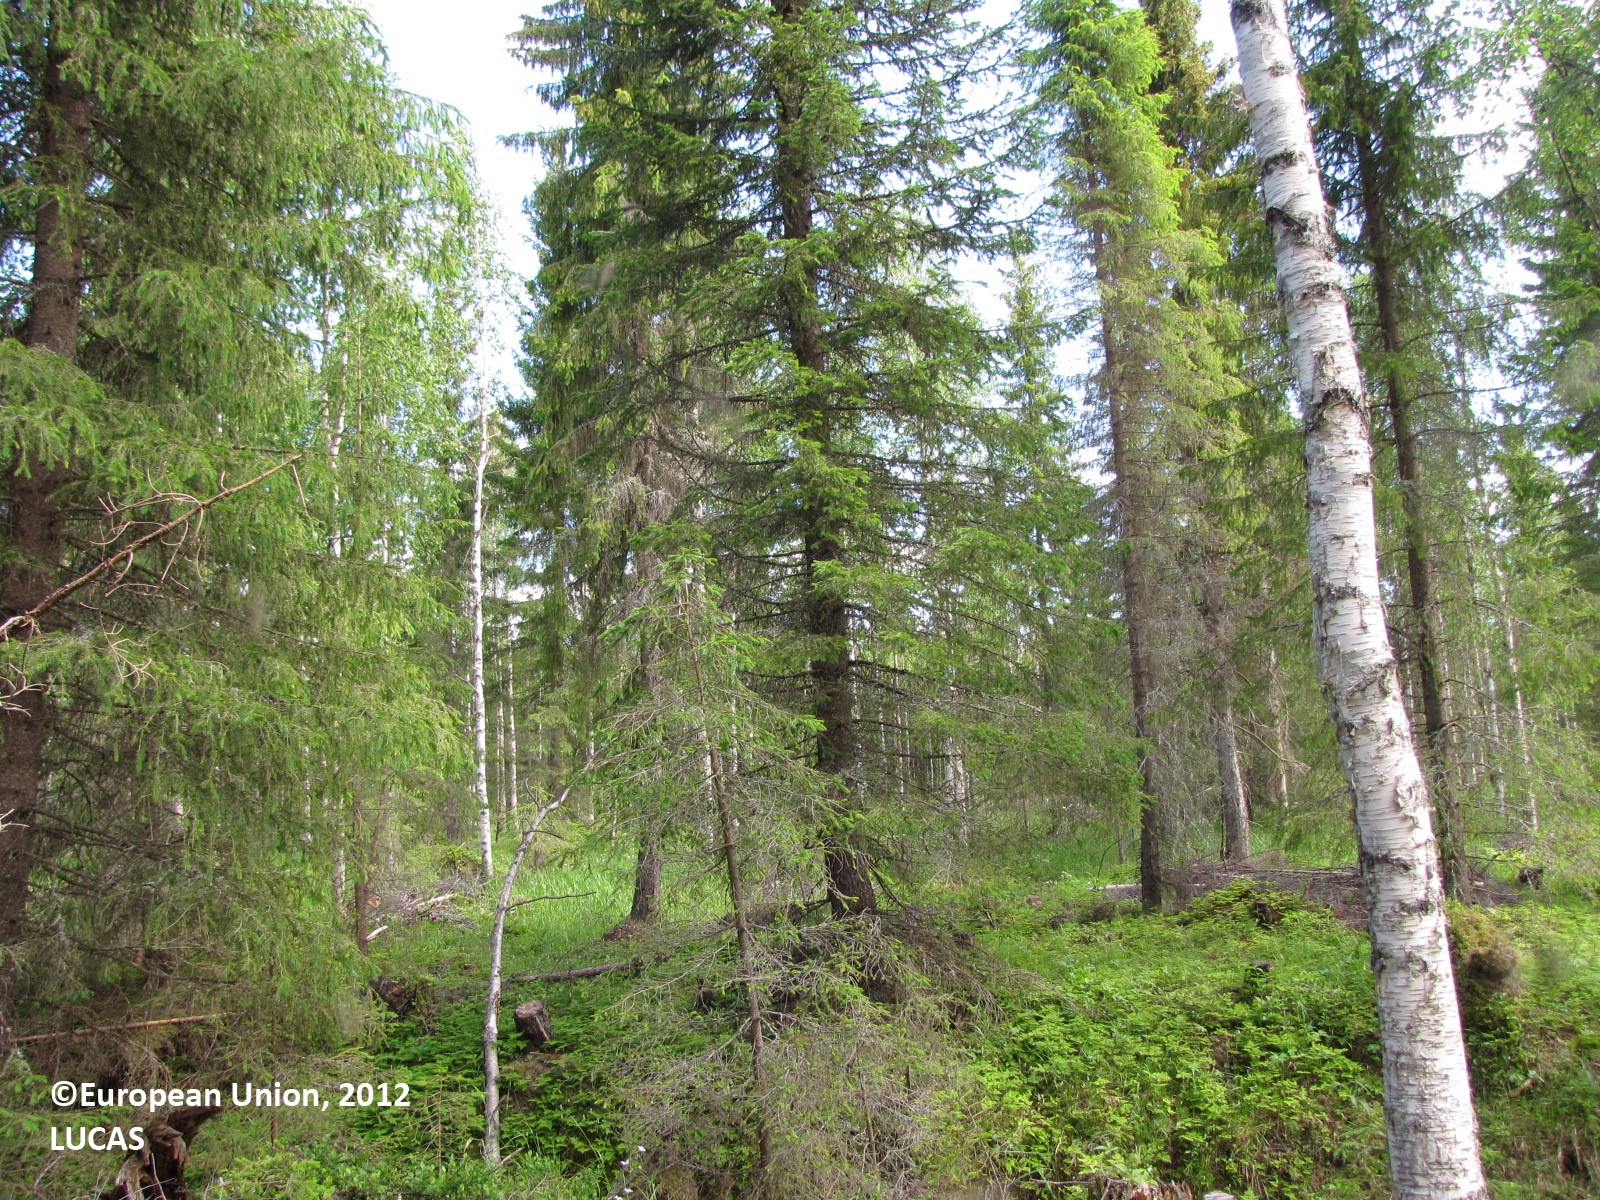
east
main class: Woodland
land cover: Spruce dominated coniferous woodland
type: boreal forest
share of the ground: 50 - 75 %
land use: Forestry
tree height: > 5 m
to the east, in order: Spruce dominated coniferous woodland; Ditches and canals; Spruce dominated mixed woodland; Ditches and canals; Other mixed woodland; Ditches and canals; Other mixed woodland; Ditches and canals; Spruce dominated mixed woodland; Ditches and canals; Spruce dominated mixed woodland; Ditches and canals
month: July
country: FI
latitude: 66.3763
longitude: 25.0168
